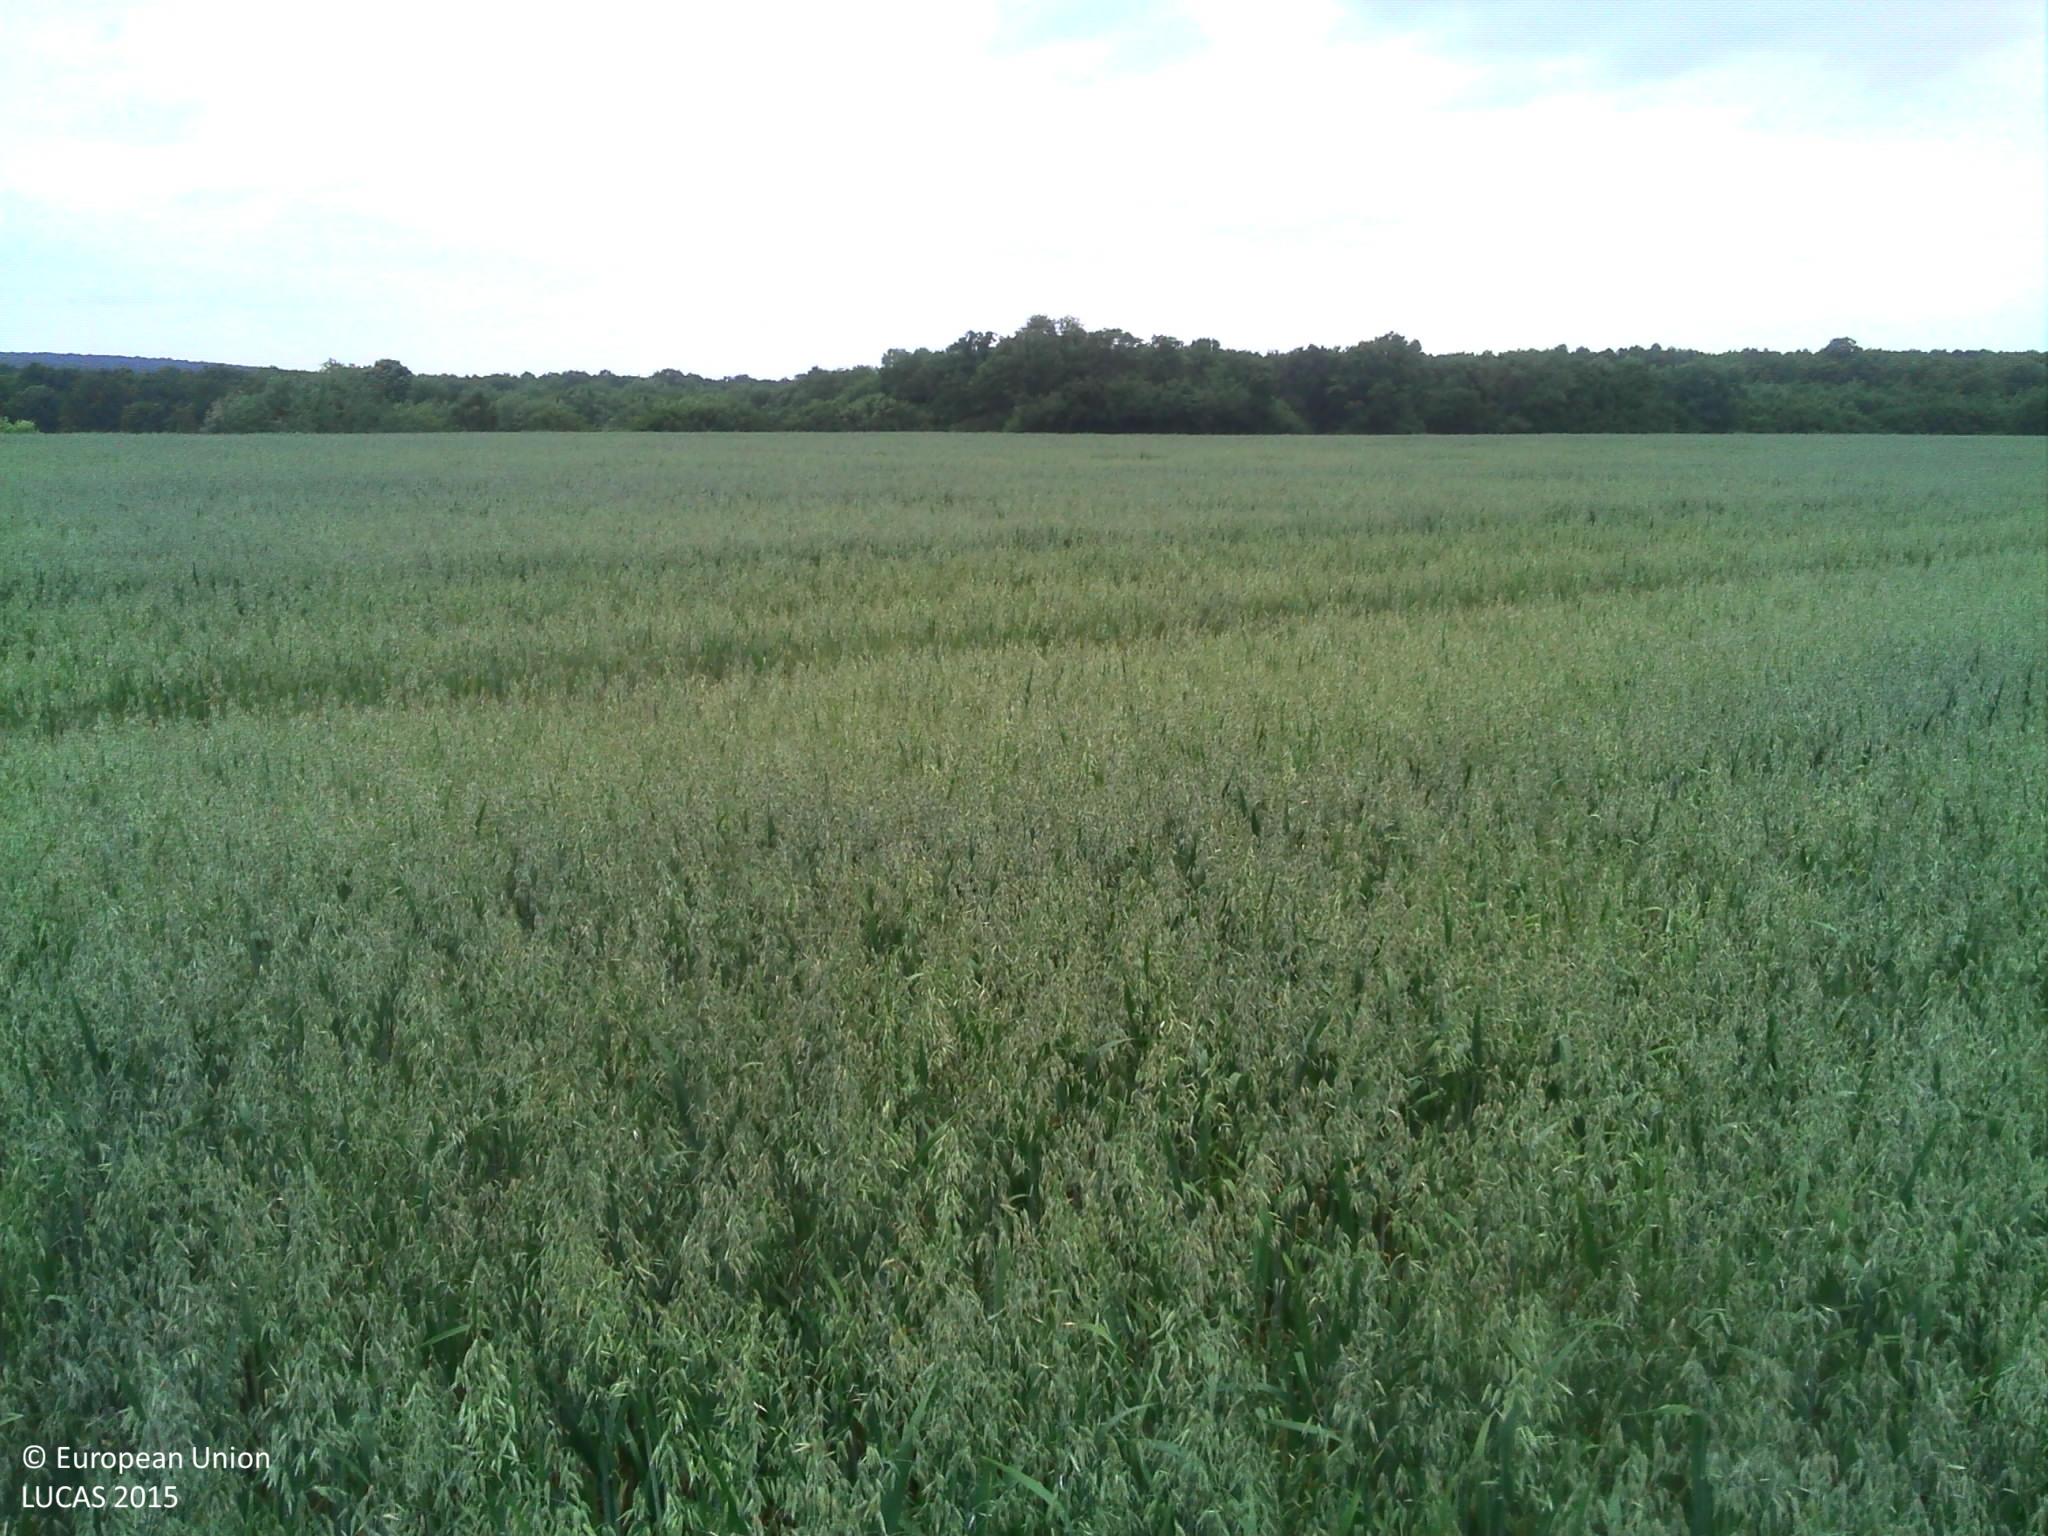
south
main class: Cropland
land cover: Oats
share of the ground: > 75 %
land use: Agriculture (excluding fallow land and kitchen gardens)
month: June
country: FR
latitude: 47.2869
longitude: 3.1332
